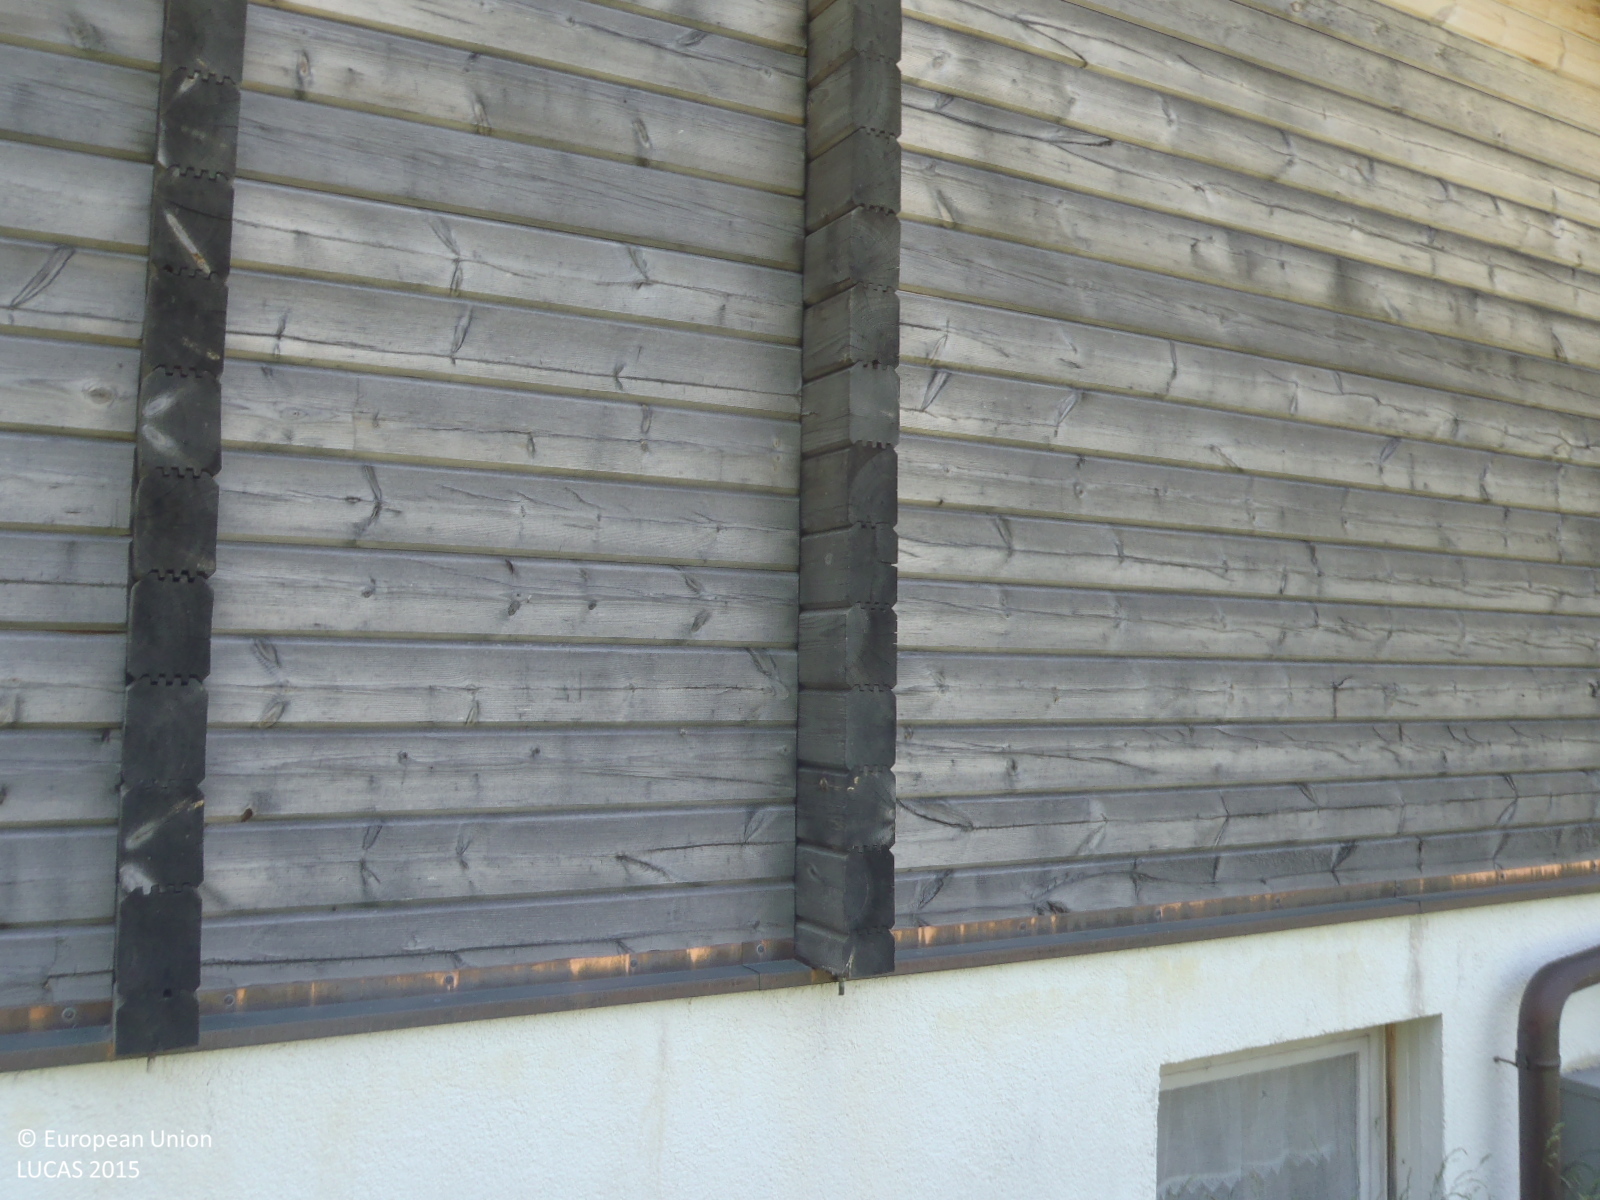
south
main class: Grassland
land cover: Grassland without tree/shrub cover
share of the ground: > 75 %
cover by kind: herbaceous plants 100 %
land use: Residential
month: July
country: AT
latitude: 46.9995
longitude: 10.0131
